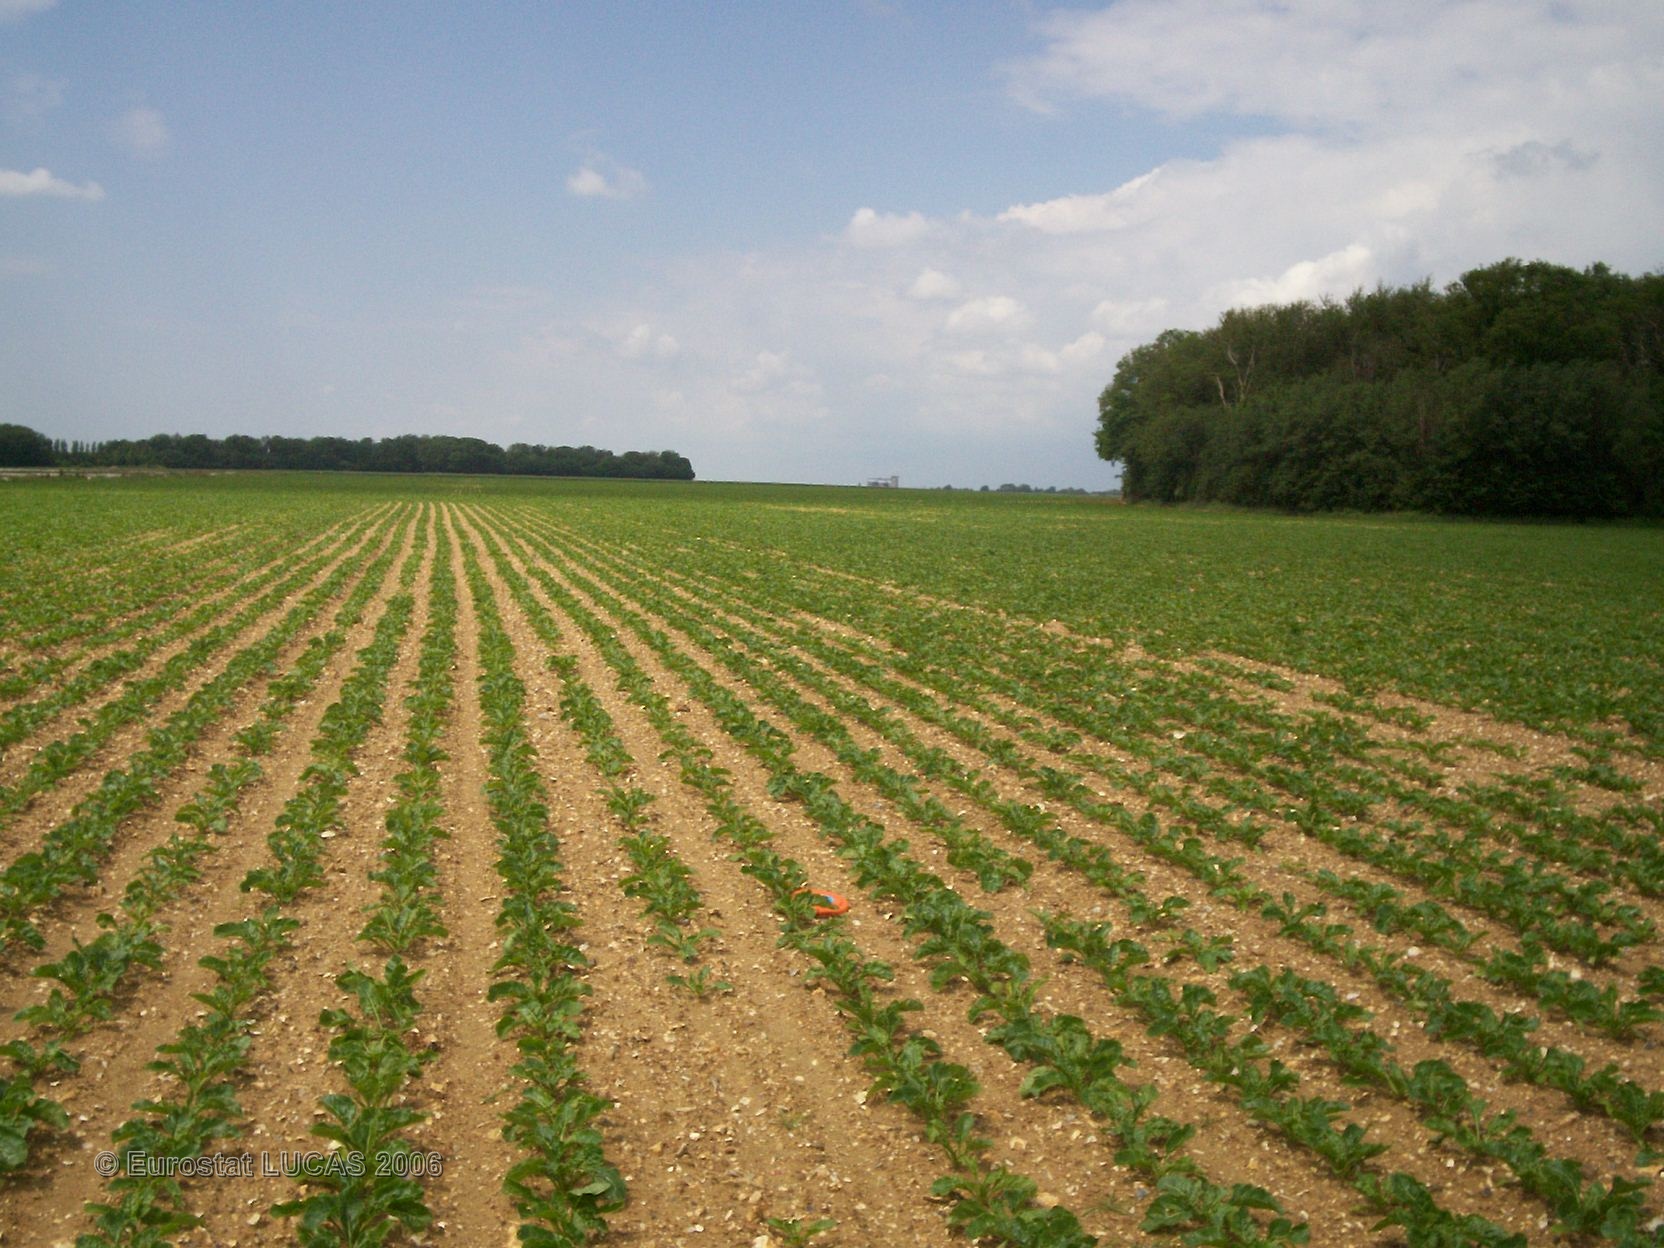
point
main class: Cropland
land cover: Sugar beet
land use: Agriculture (excluding fallow land and kitchen gardens)
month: June
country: FR
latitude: 49.7283
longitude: 2.6220
